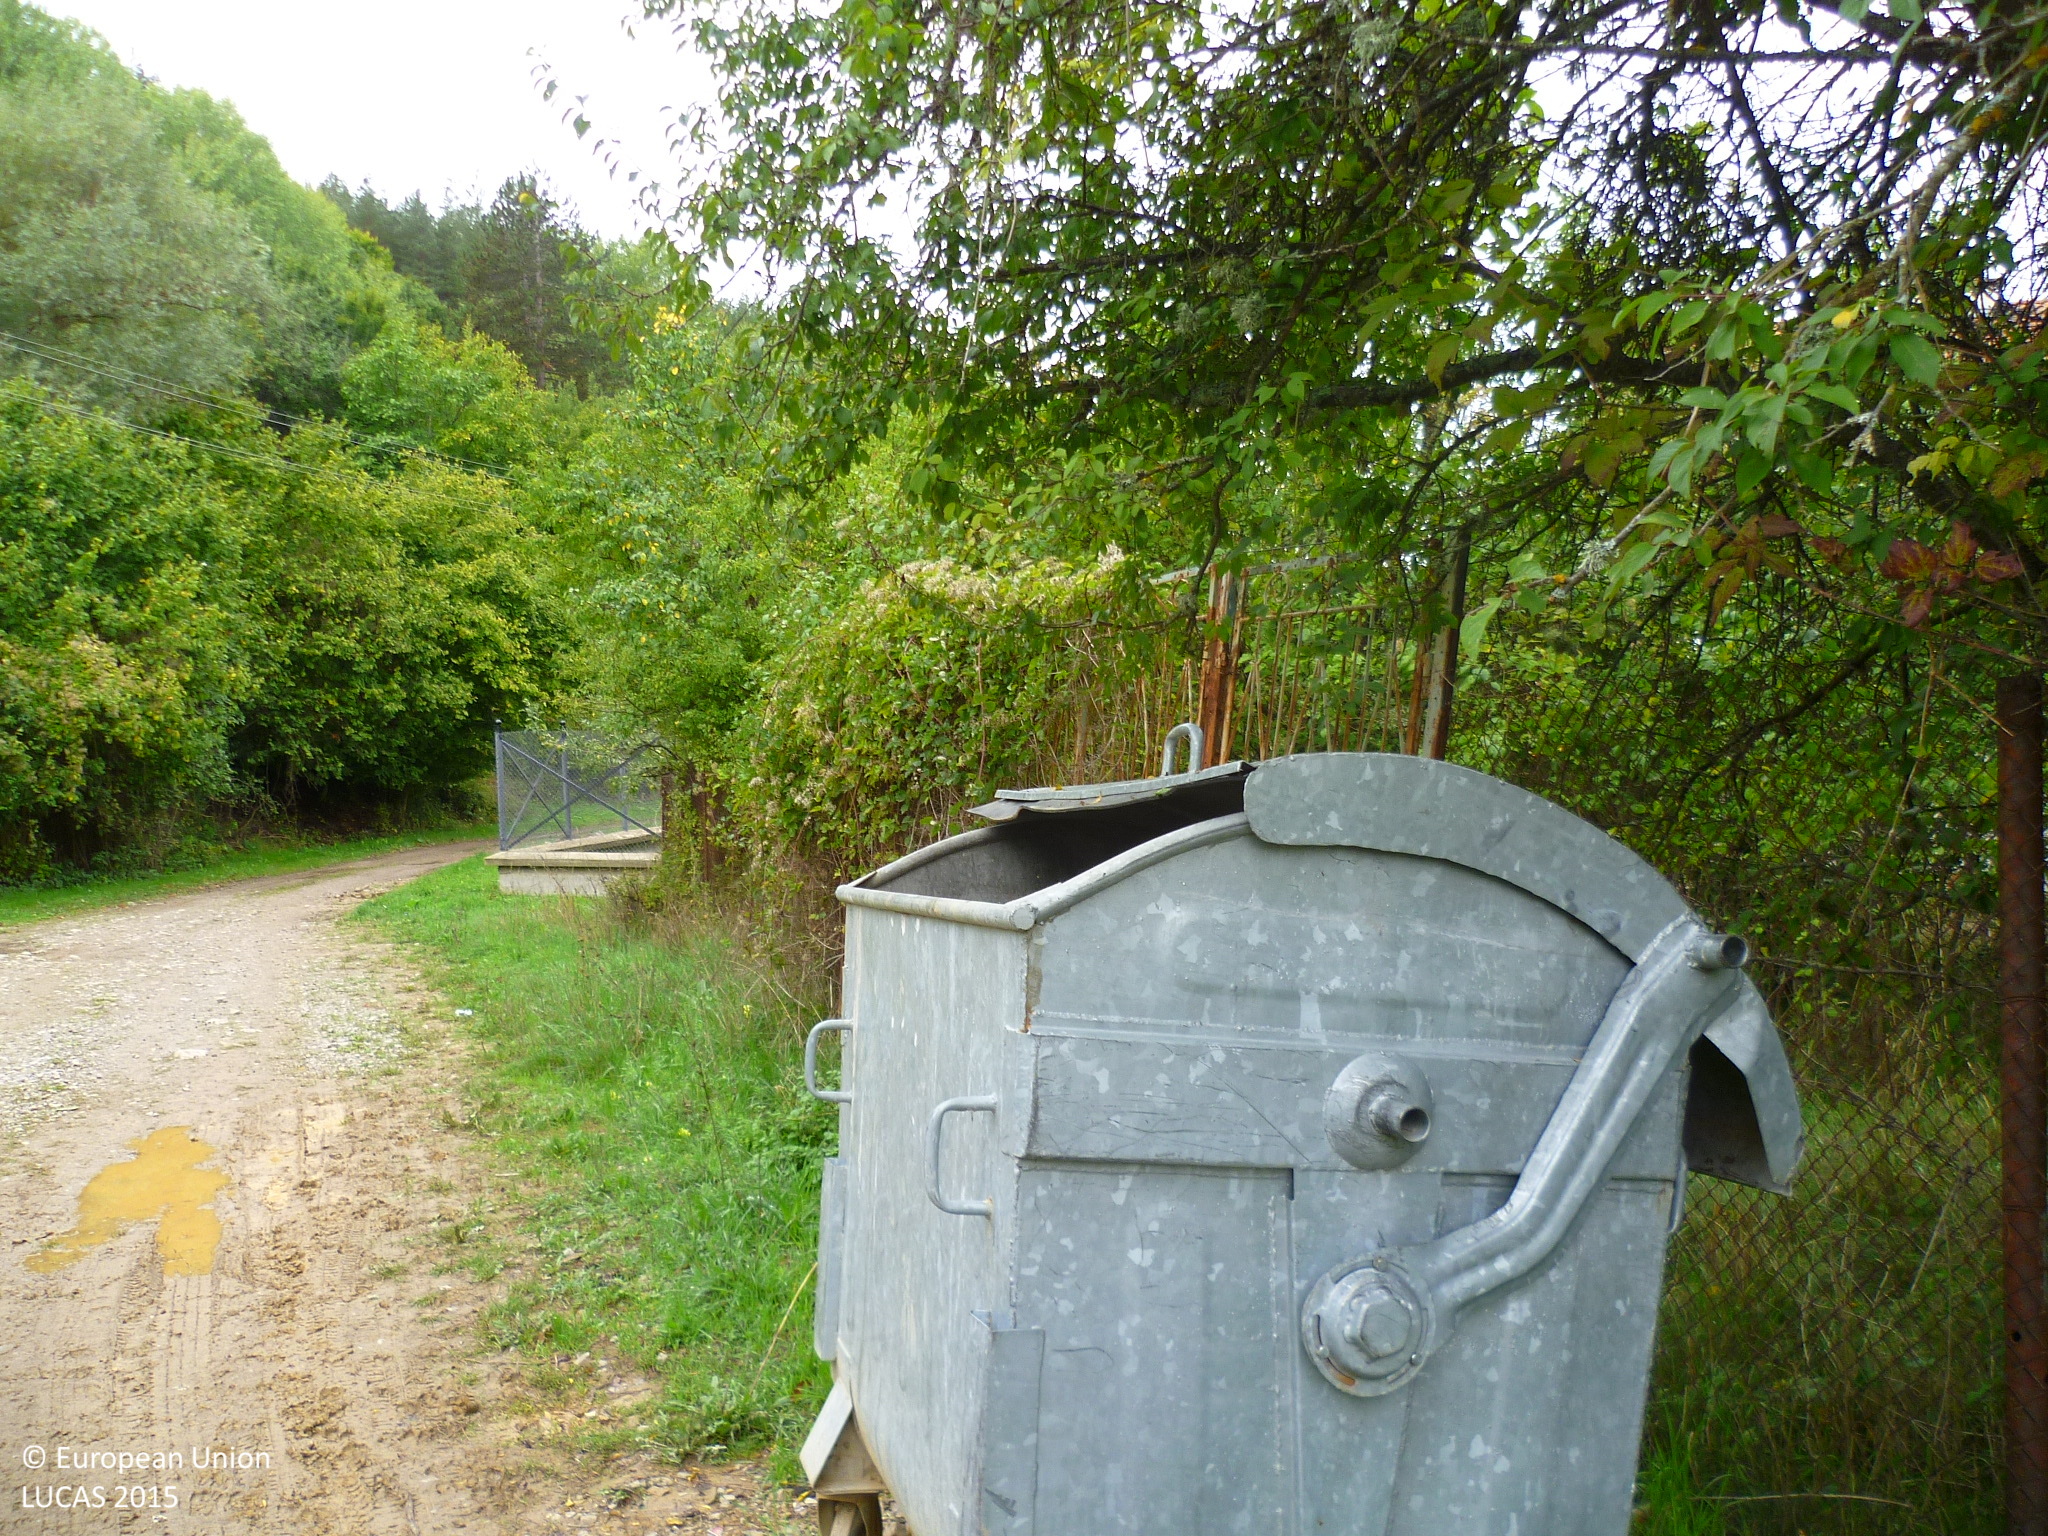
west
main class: Cropland
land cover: Nuts trees
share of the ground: 50 - 75 %
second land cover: Spontaneously vegetated surfaces
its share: 50 - 75 %
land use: Kitchen garden
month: September
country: BG
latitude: 42.6691
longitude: 22.7276
